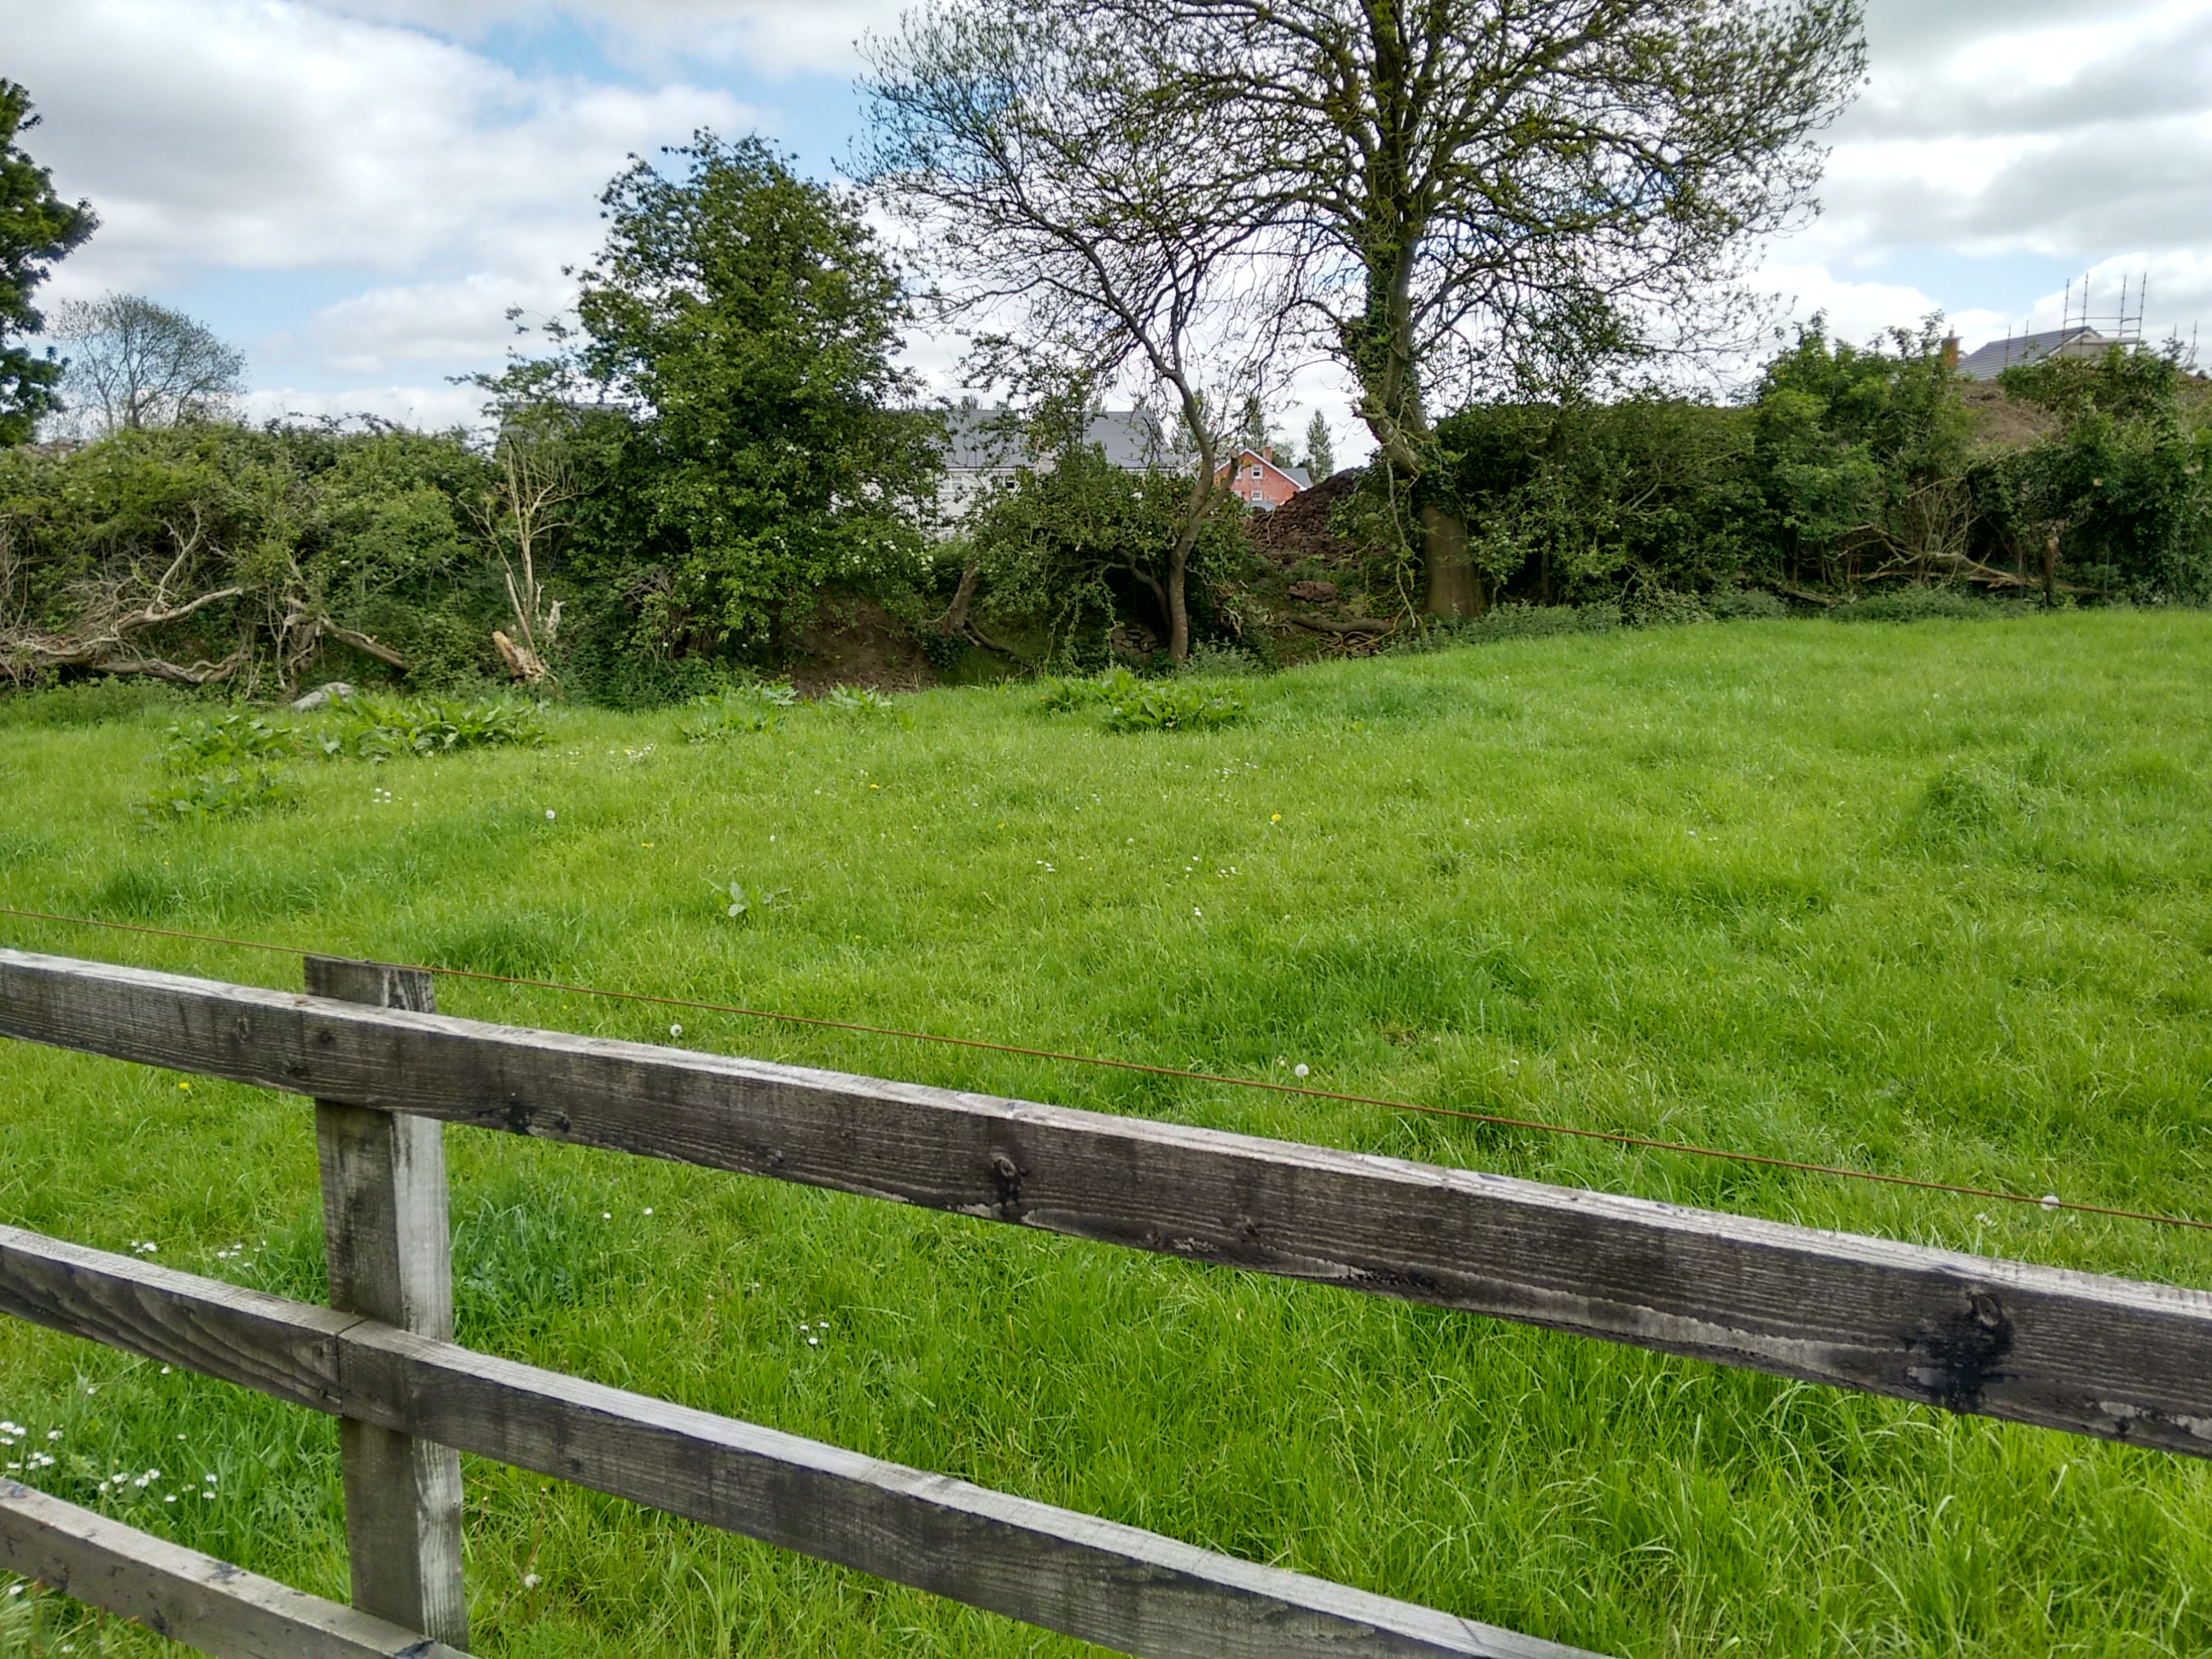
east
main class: Grassland
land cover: Grassland without tree/shrub cover
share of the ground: > 75 %
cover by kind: herbaceous plants 100 %
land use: Agriculture (excluding fallow land and kitchen gardens)
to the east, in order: Grassland without tree/shrub cover; Managed hedges; Grassland without tree/shrub cover
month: May
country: IE
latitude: 53.5019
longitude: -6.5459
